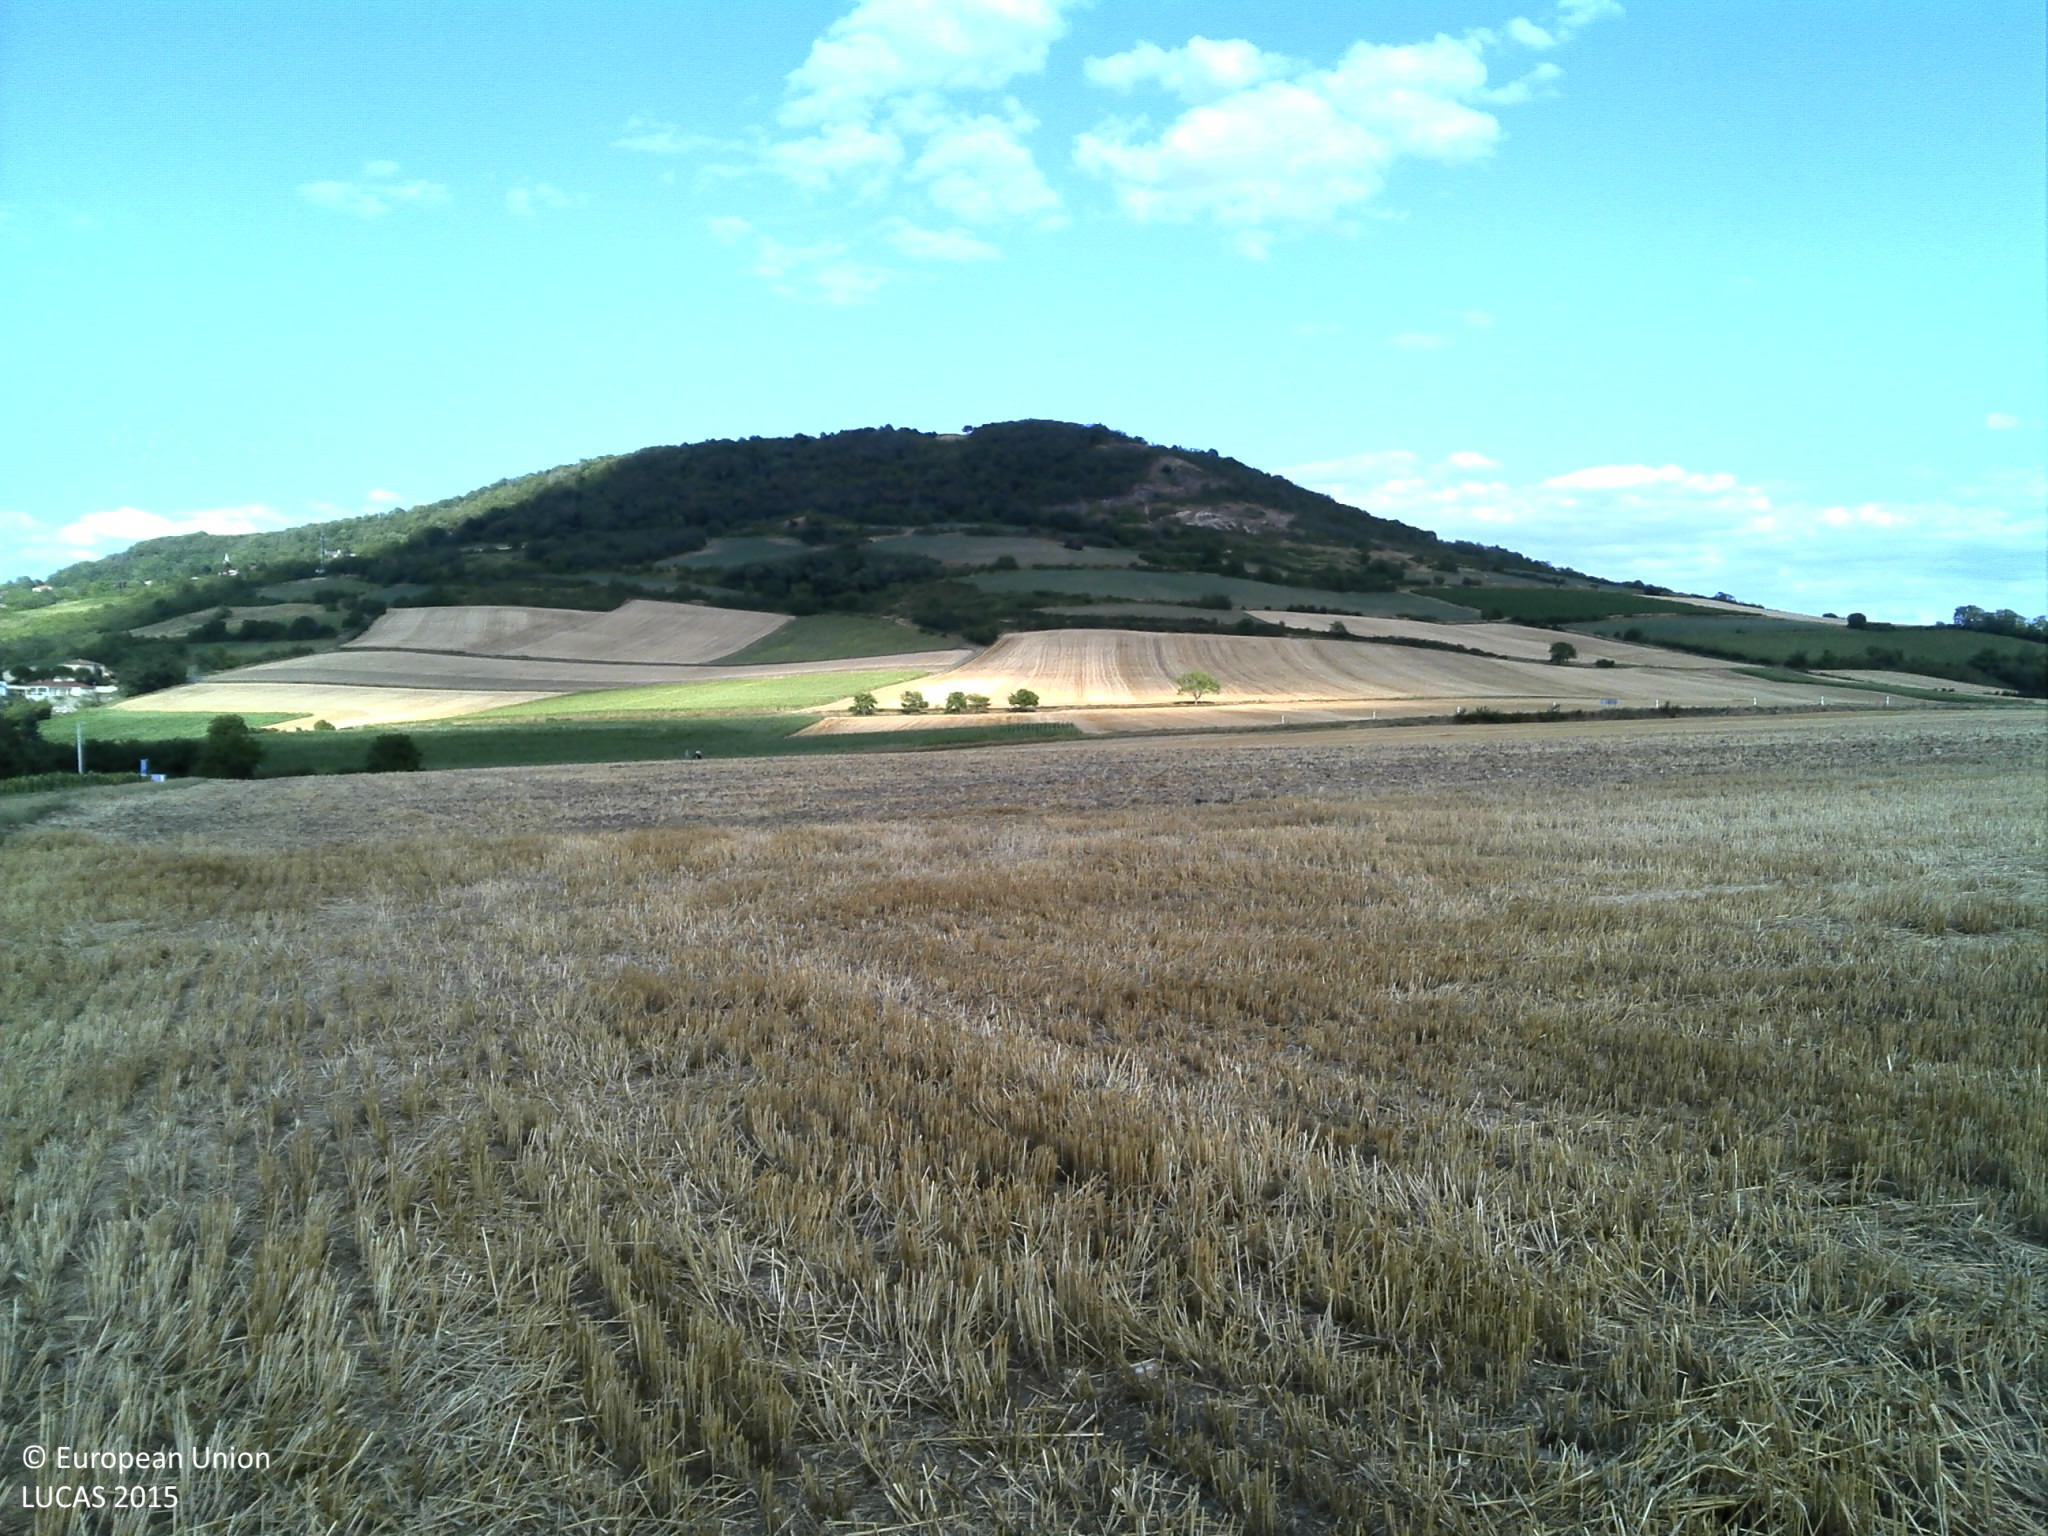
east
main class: Cropland
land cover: Common wheat
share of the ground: > 75 %
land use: Agriculture (excluding fallow land and kitchen gardens)
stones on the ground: 25 - 50 %
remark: Harvested field
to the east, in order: Common wheat; Electric lines; Common wheat; Grass margins; Common wheat
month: July
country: FR
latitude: 45.6621
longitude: 3.1595
